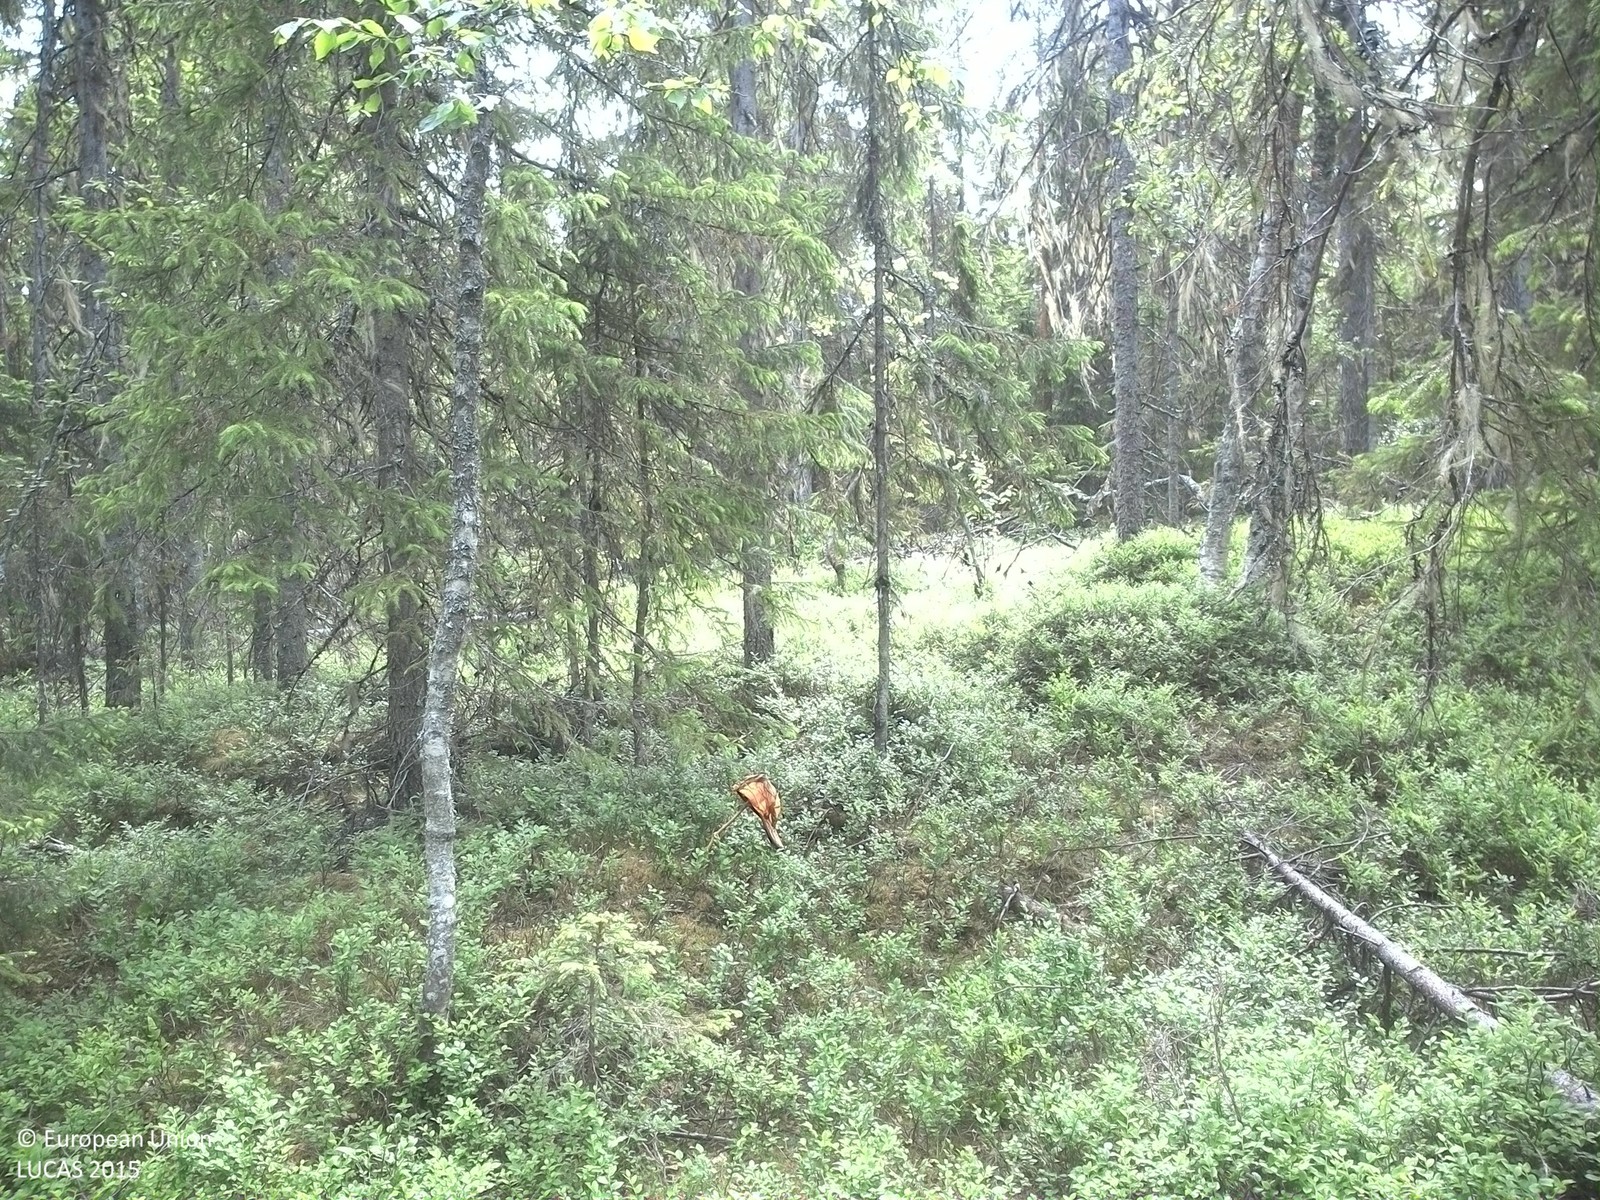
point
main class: Woodland
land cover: Spruce dominated coniferous woodland
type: boreal forest
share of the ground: 50 - 75 %
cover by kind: coniferous forest trees 60 %, shrubs 30 %, broadleaved forest trees 10 %
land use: Forestry
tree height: > 5 m
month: June
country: SE
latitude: 62.8544
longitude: 17.6205
